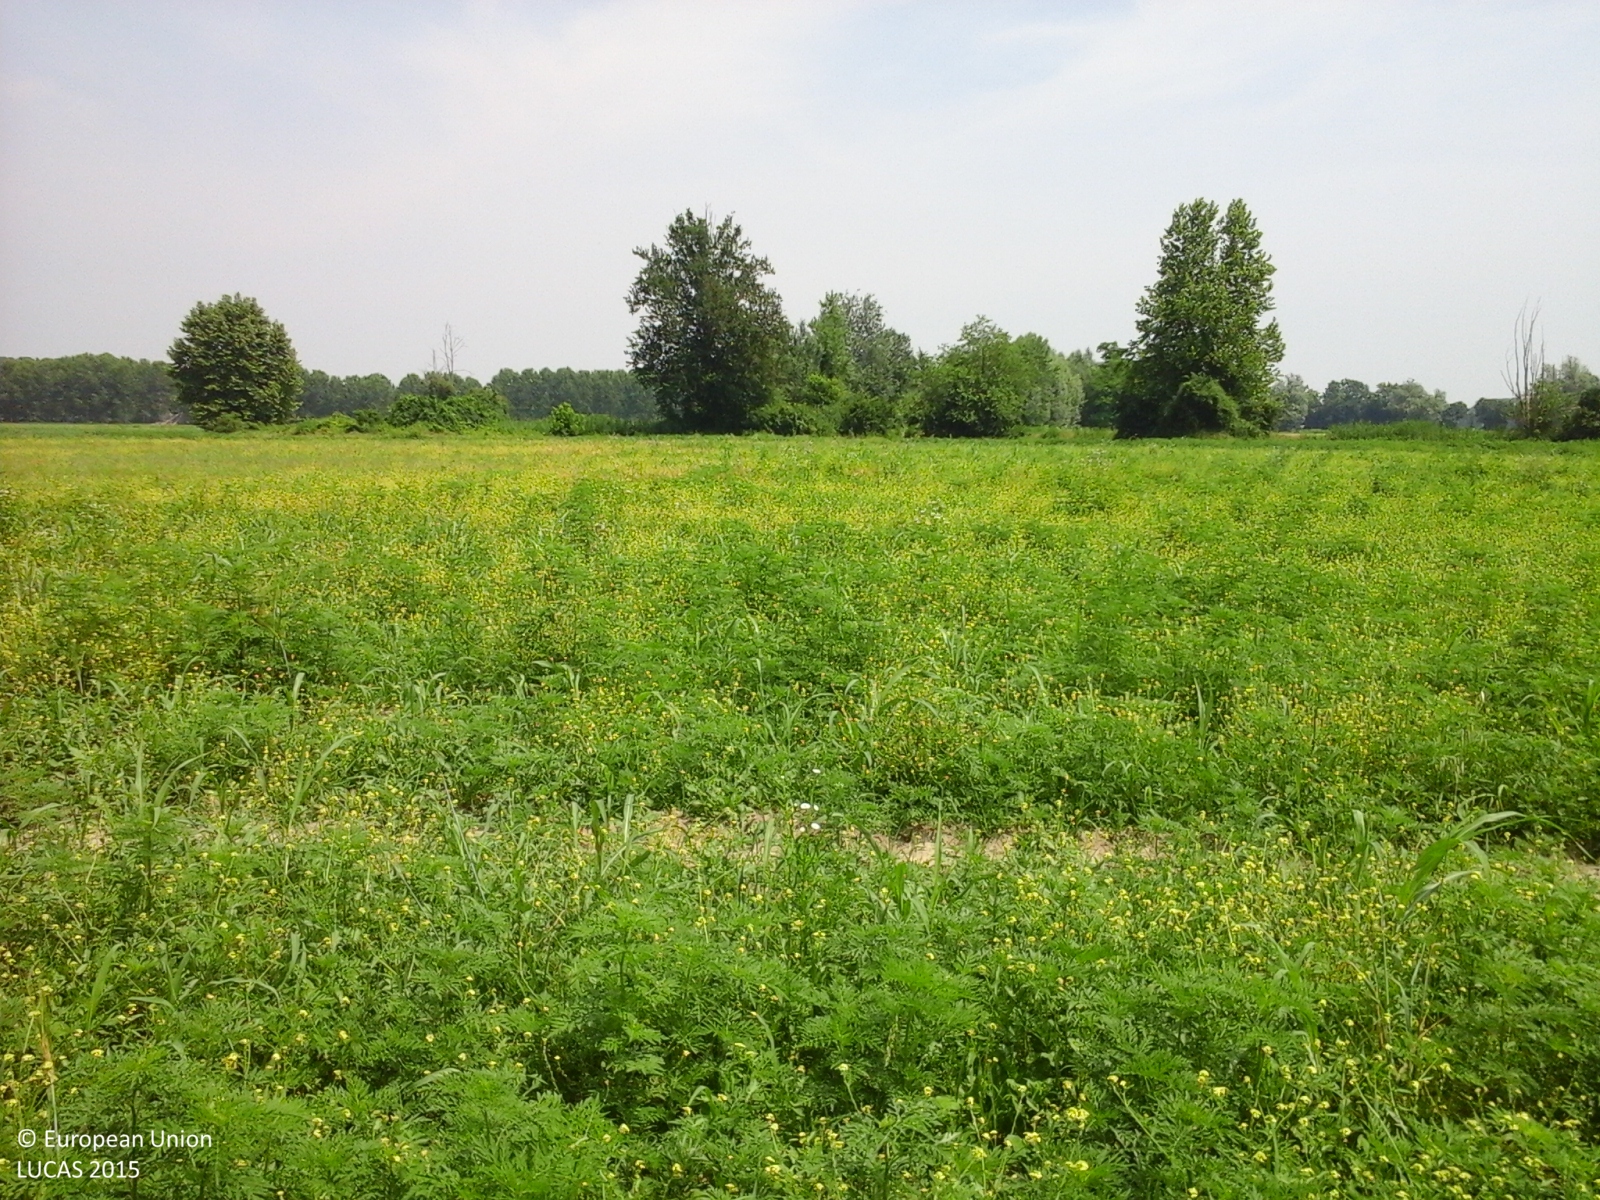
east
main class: Grassland
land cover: Spontaneously vegetated surfaces
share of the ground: > 75 %
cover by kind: herbaceous plants 100 %
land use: Agriculture (excluding fallow land and kitchen gardens)
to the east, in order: Spontaneously vegetated surfaces; Tracks; Shrubland with sparse tree cover; Inland fresh running water; Shrubland with sparse tree cover; Inland fresh running water; Shrubland with sparse tree cover; Tracks; Spontaneously vegetated surfaces
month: June
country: IT
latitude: 45.2695
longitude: 9.6565
